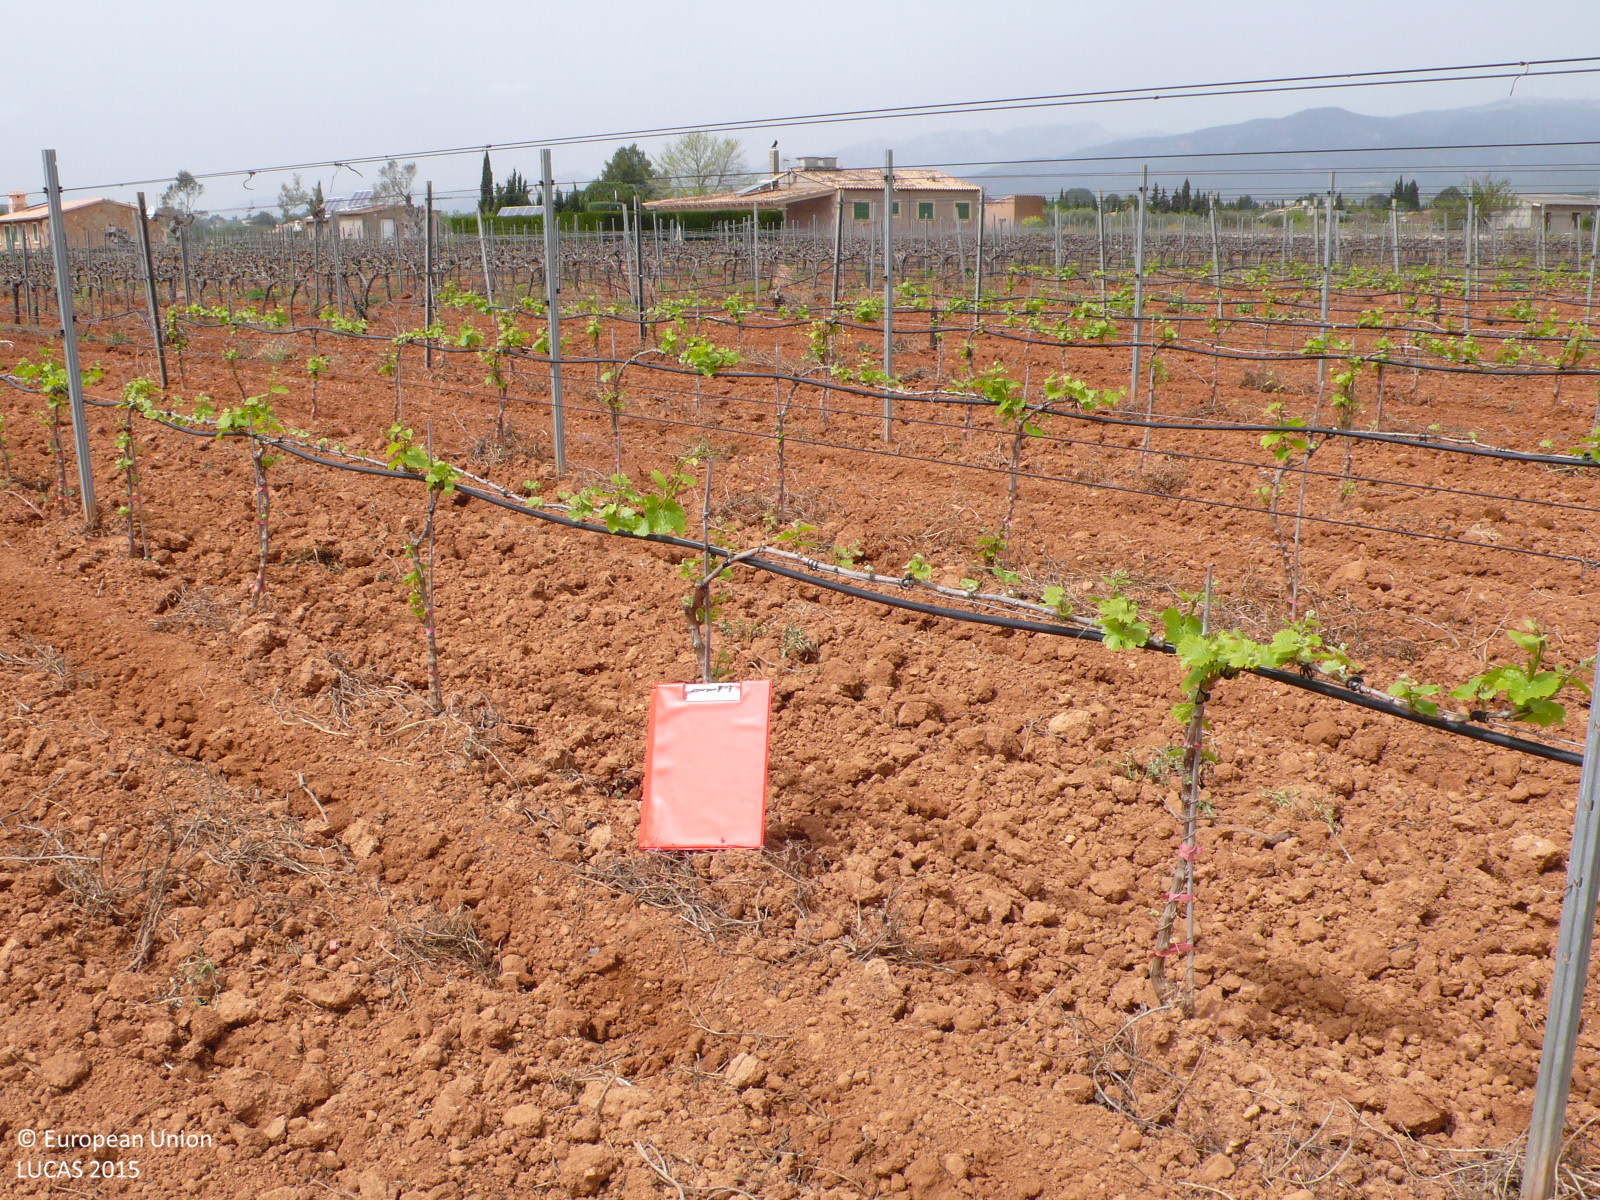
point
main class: Cropland
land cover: Vineyards
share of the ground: < 10 %
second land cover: Other bare soil
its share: > 75 %
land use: Agriculture (excluding fallow land and kitchen gardens)
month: April
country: ES
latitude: 39.6387
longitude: 2.7940
